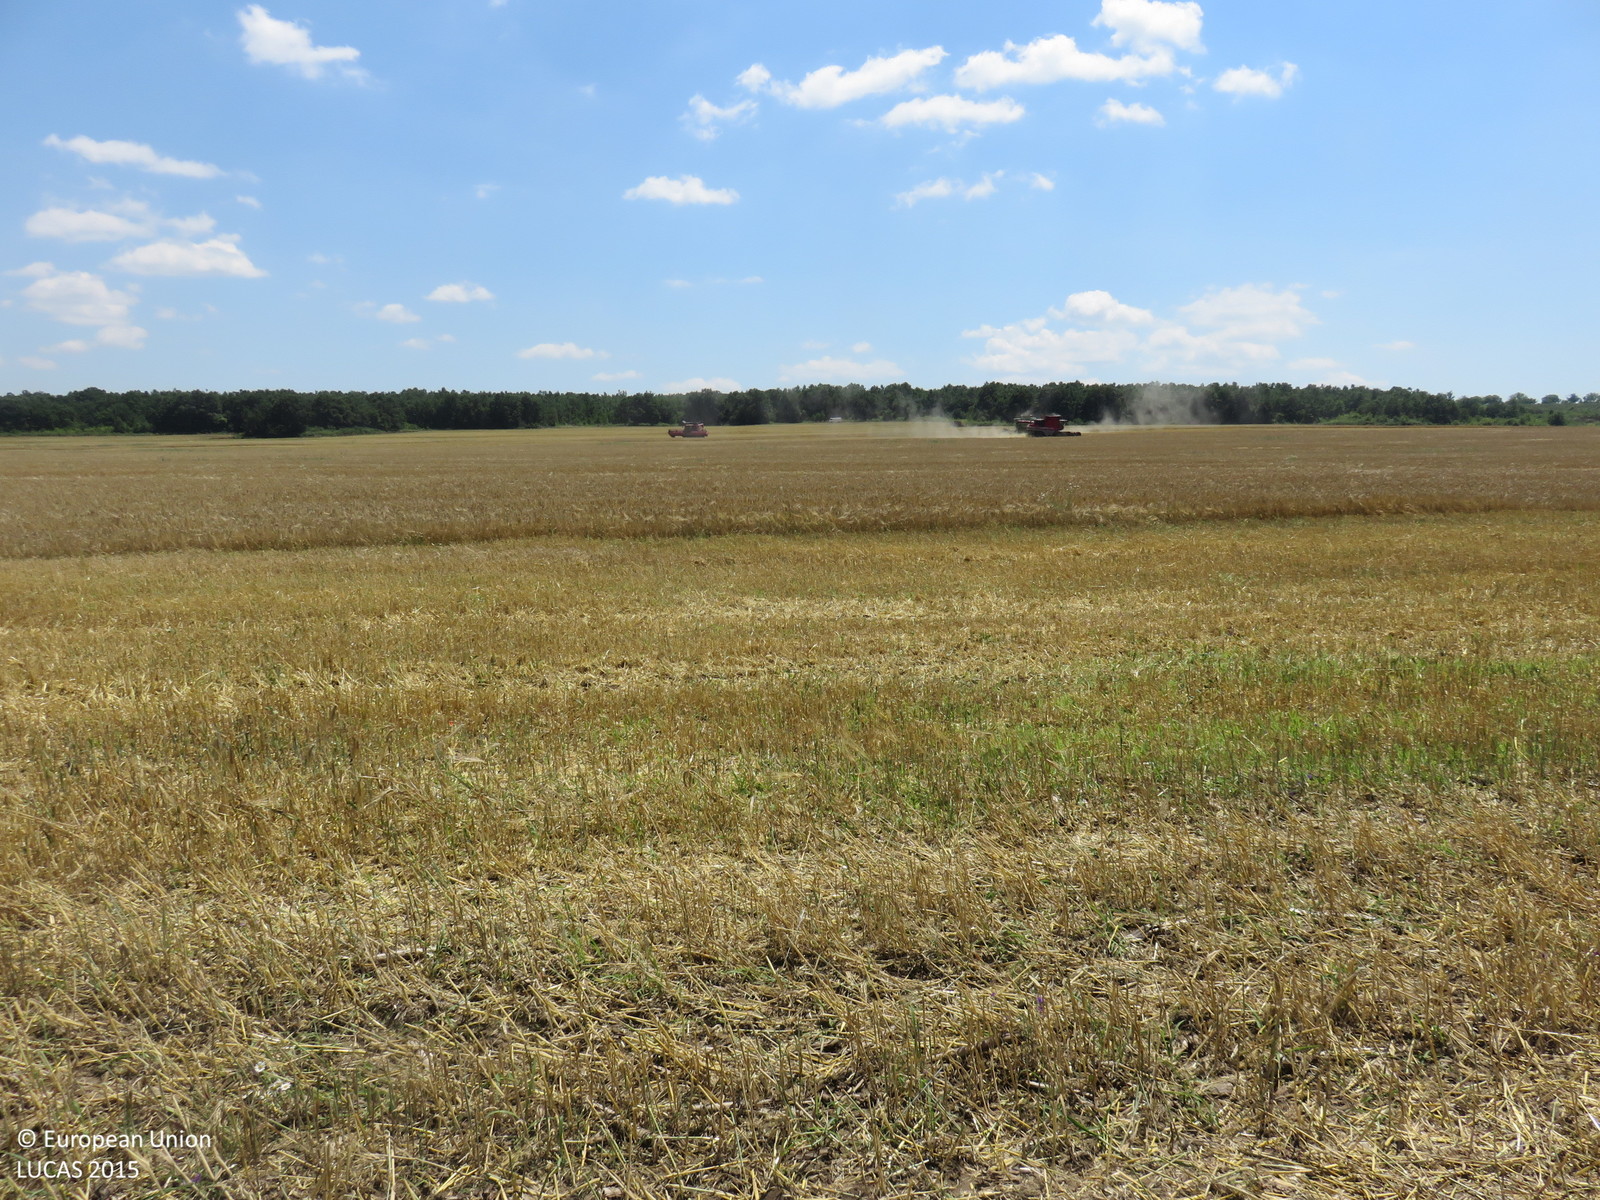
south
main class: Cropland
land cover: Barley
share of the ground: > 75 %
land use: Agriculture (excluding fallow land and kitchen gardens)
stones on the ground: < 10 %
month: June
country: BG
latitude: 43.2588
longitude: 24.8354
